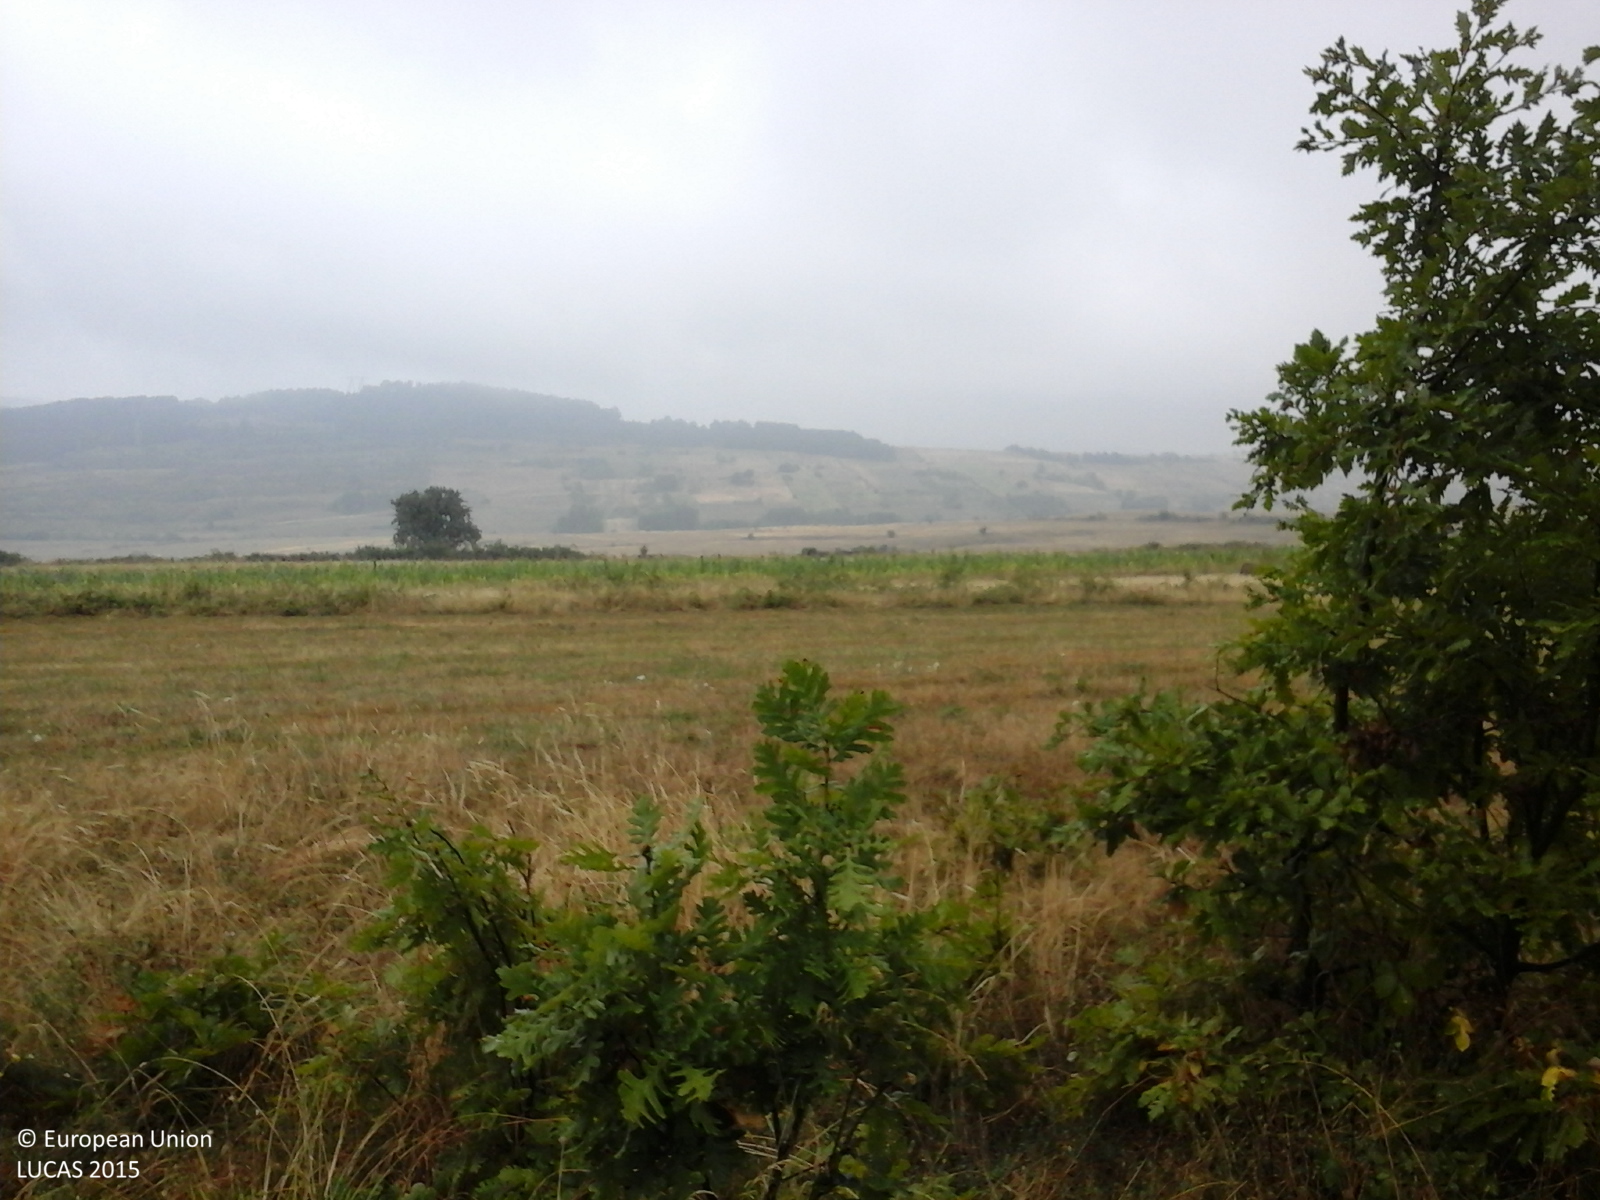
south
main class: Shrubland
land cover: Shrubland with sparse tree cover
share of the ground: > 75 %
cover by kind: shrubs 80 %, herbaceous plants 15 %, broadleaved forest trees 5 %
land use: Agriculture (excluding fallow land and kitchen gardens)
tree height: < 5 m
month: August
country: RO
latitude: 44.7653
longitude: 22.7413
